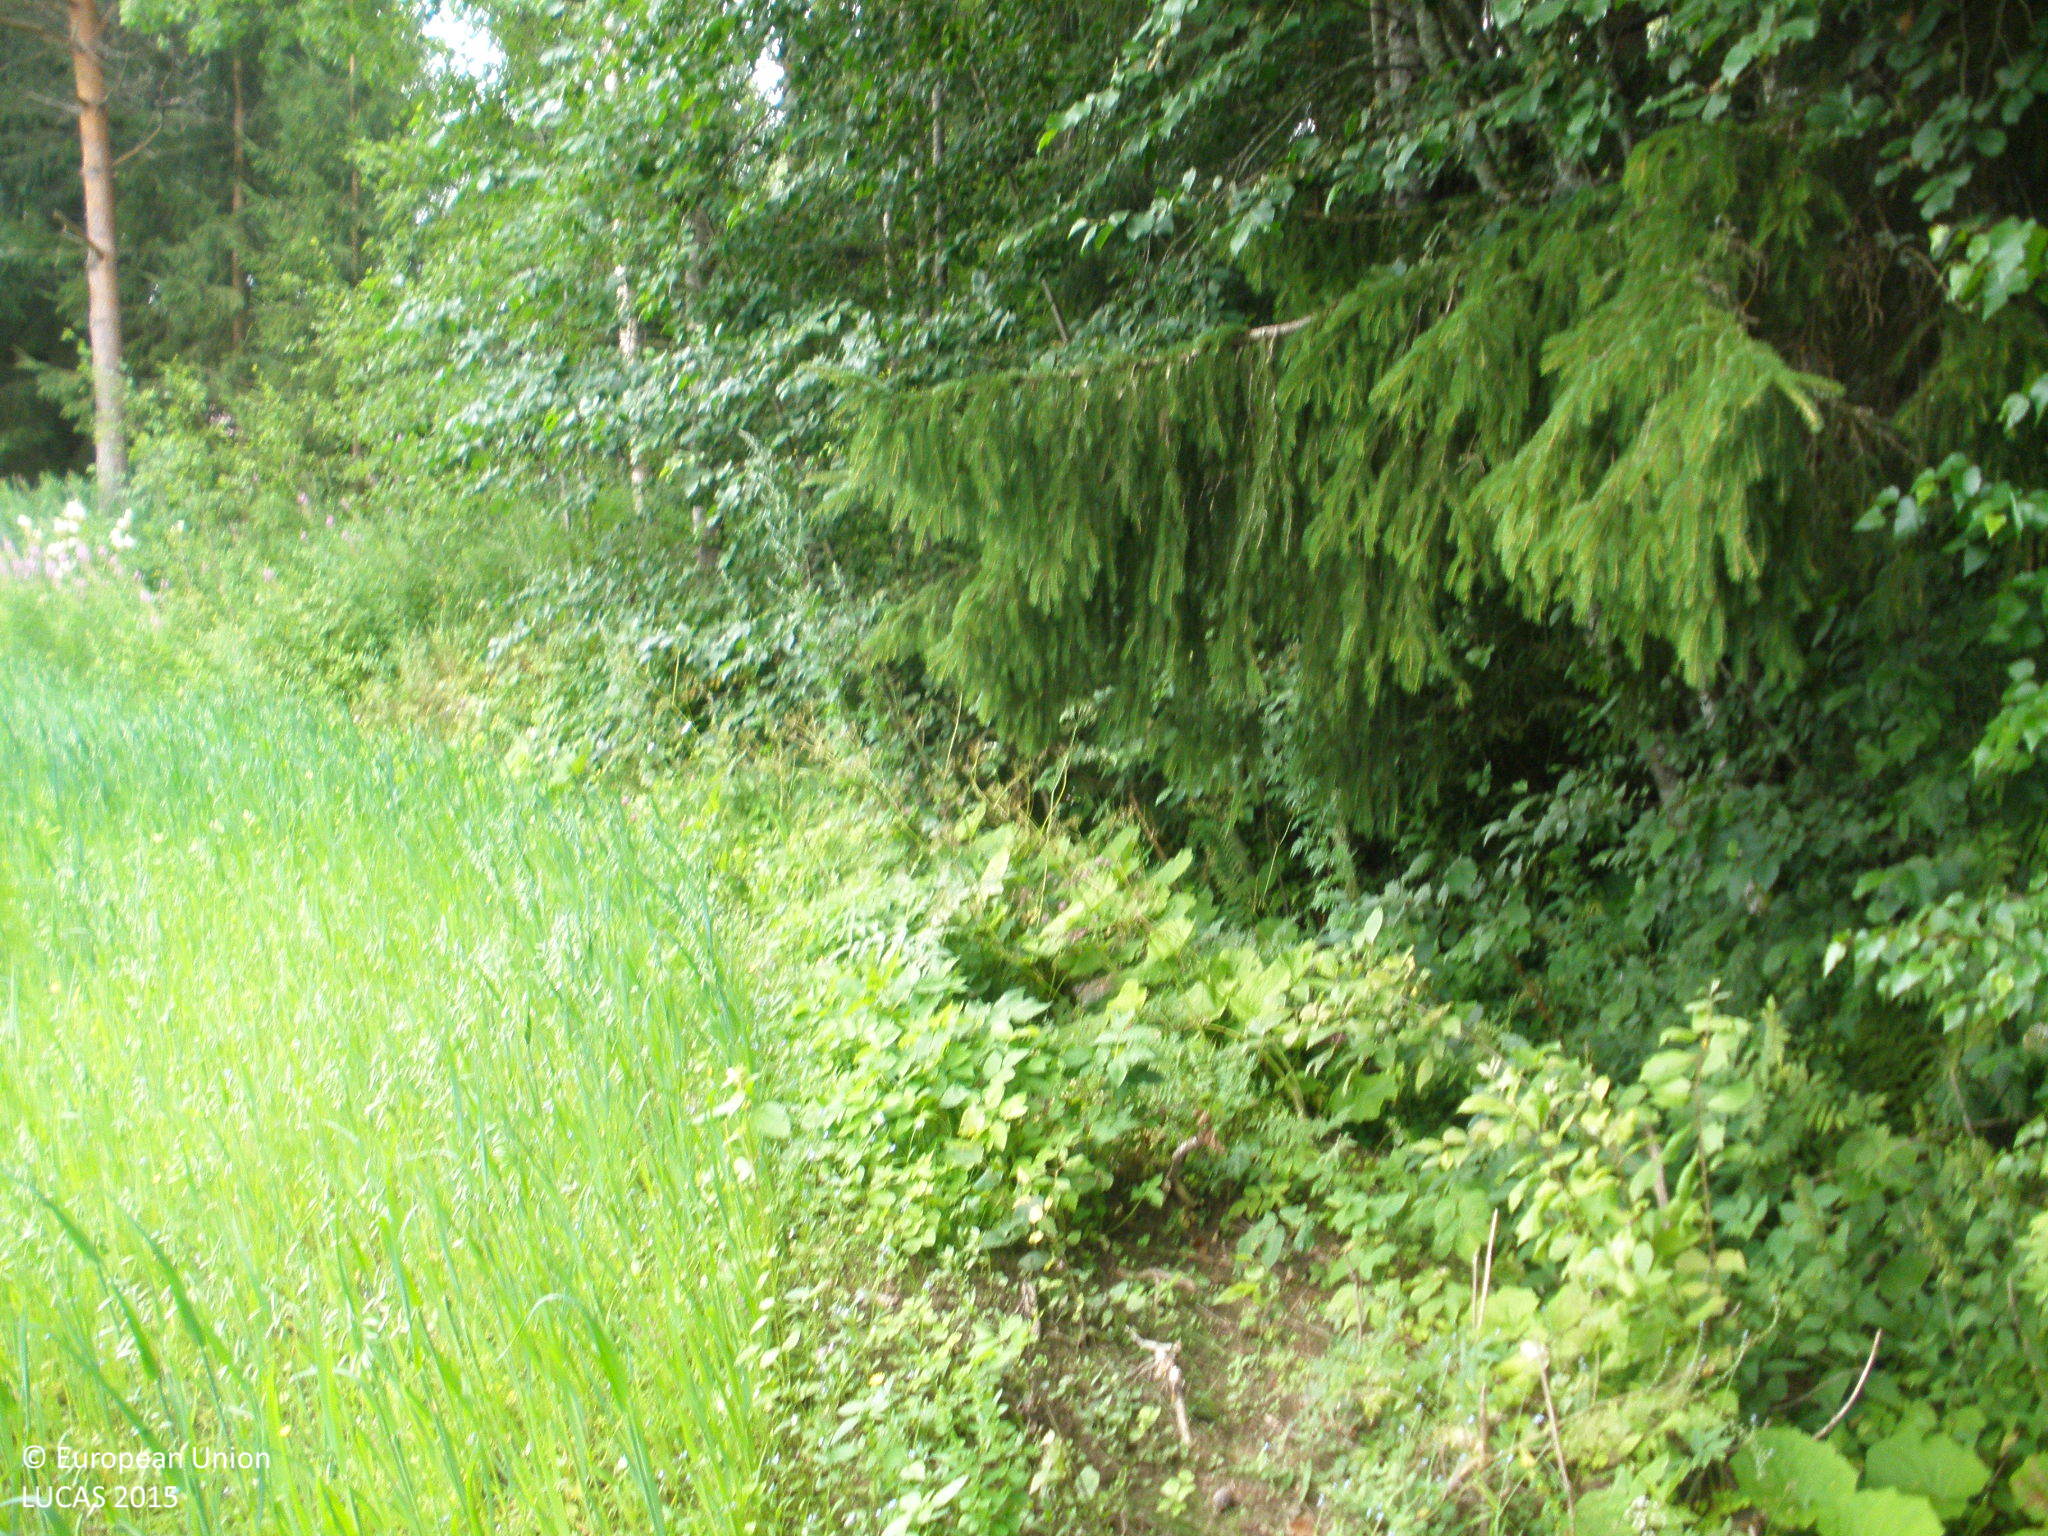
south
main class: Cropland
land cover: Oats
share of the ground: 50 - 75 %
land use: Agriculture (excluding fallow land and kitchen gardens)
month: August
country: FI
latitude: 60.9500
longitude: 24.6731
